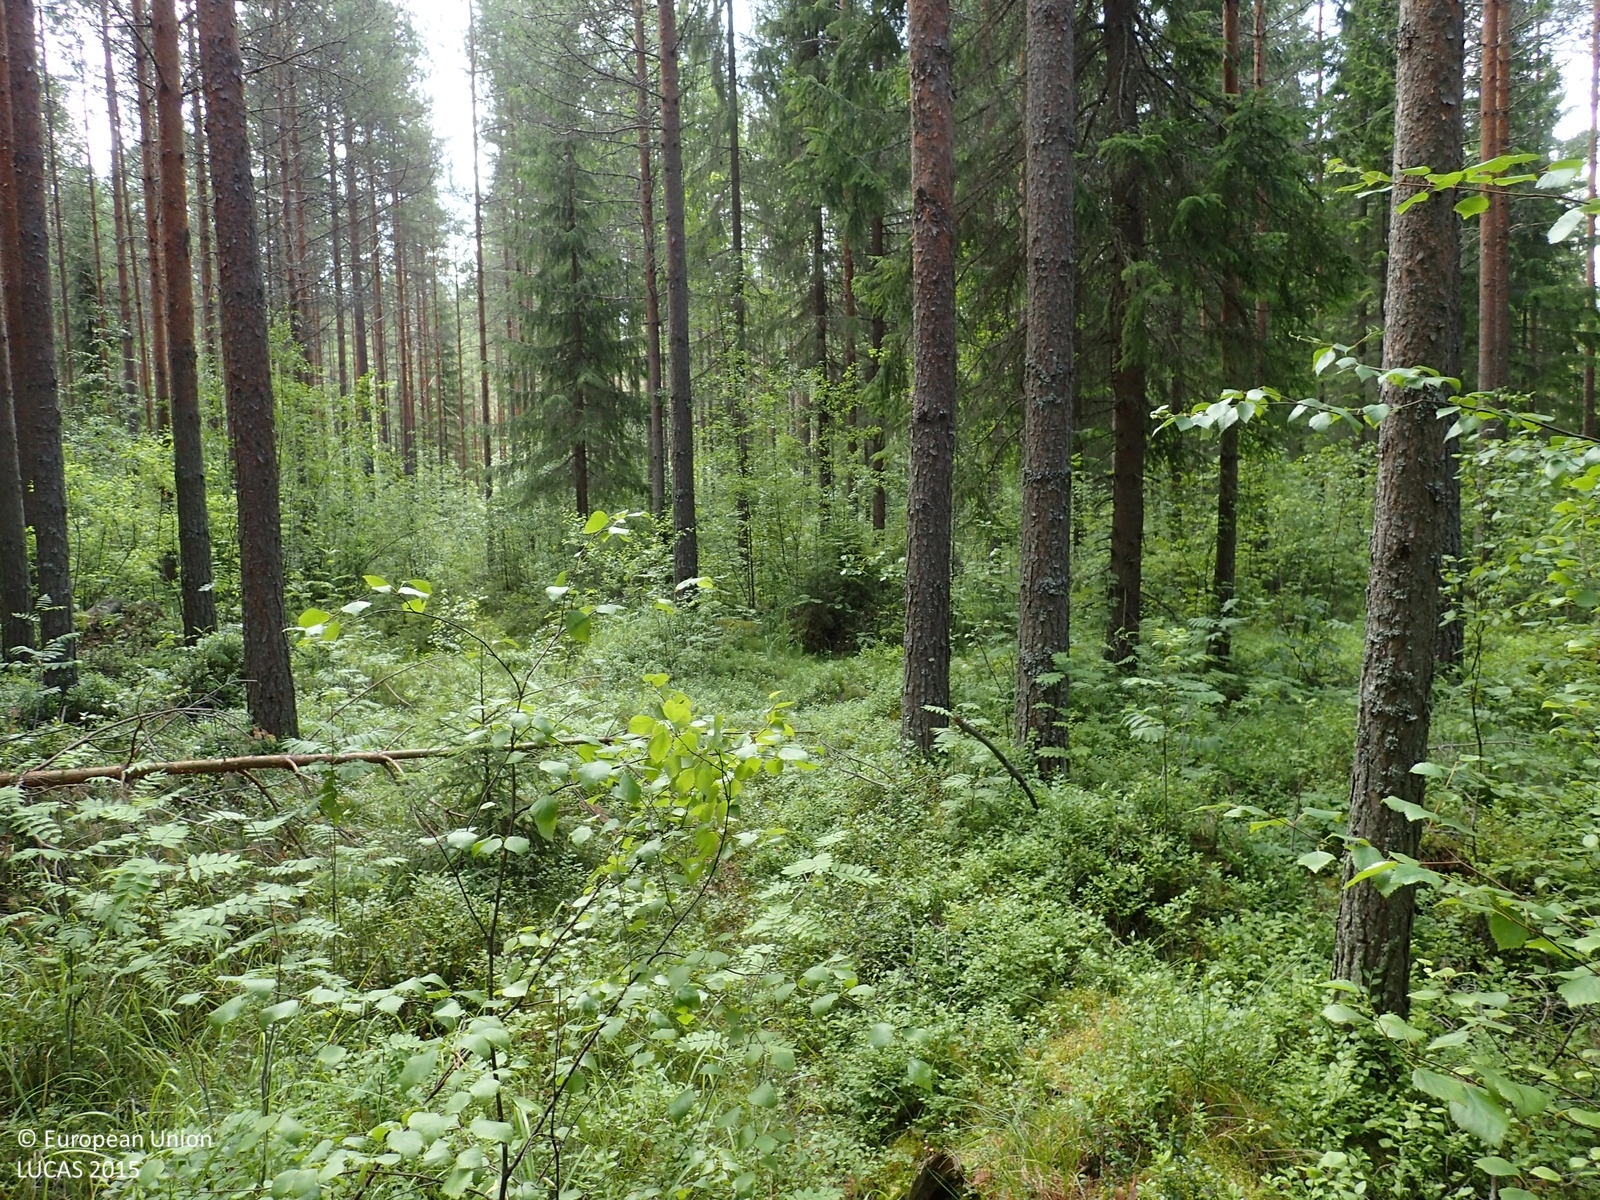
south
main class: Woodland
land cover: Pine dominated coniferous woodland
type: boreal forest
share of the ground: 50 - 75 %
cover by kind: coniferous forest trees 55 %, shrubs 30 %, broadleaved forest trees 10 %, herbaceous plants 5 %
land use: Forestry
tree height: > 5 m
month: July
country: FI
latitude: 62.7654
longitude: 23.5651
